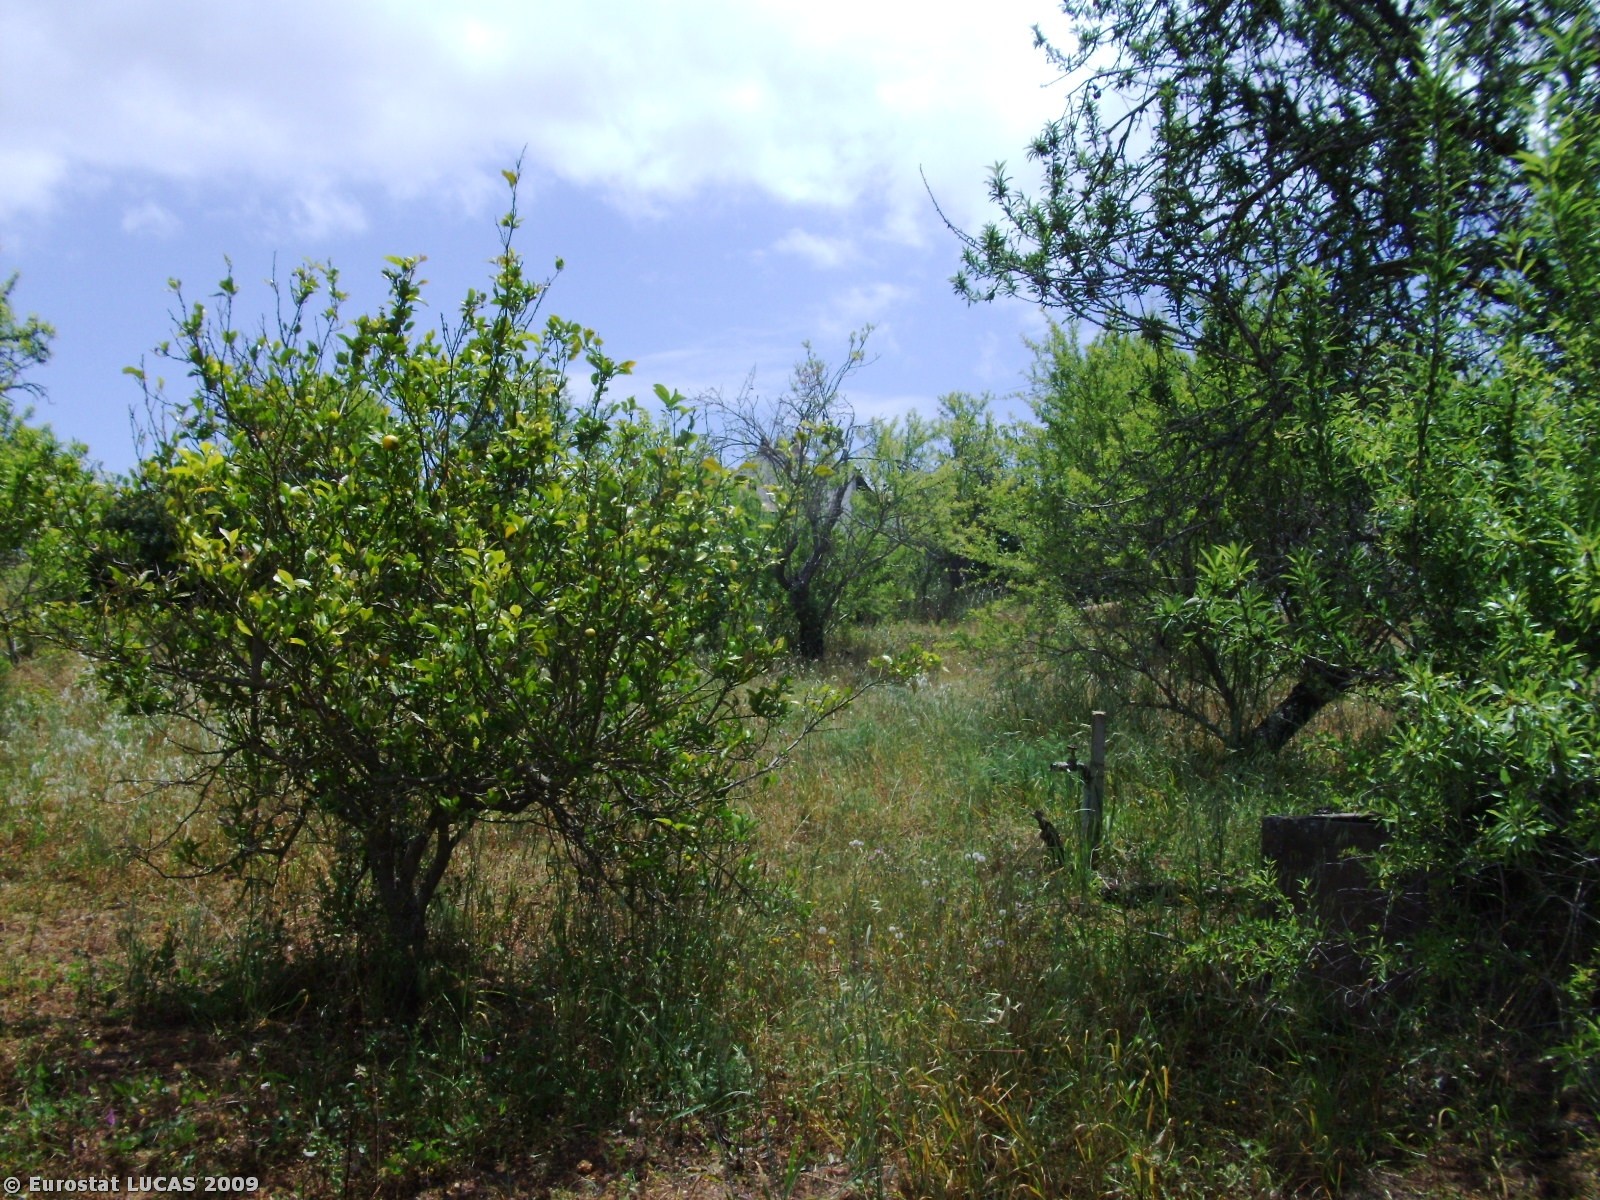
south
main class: Cropland
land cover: Permanent industrial crops
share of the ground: 10 - 25 %
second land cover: Spontaneously vegetated surfaces
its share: 50 - 75 %
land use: Agriculture (excluding fallow land and kitchen gardens)
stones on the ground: 10 - 25 %
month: May
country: PT
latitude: 37.1082
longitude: -8.4667
